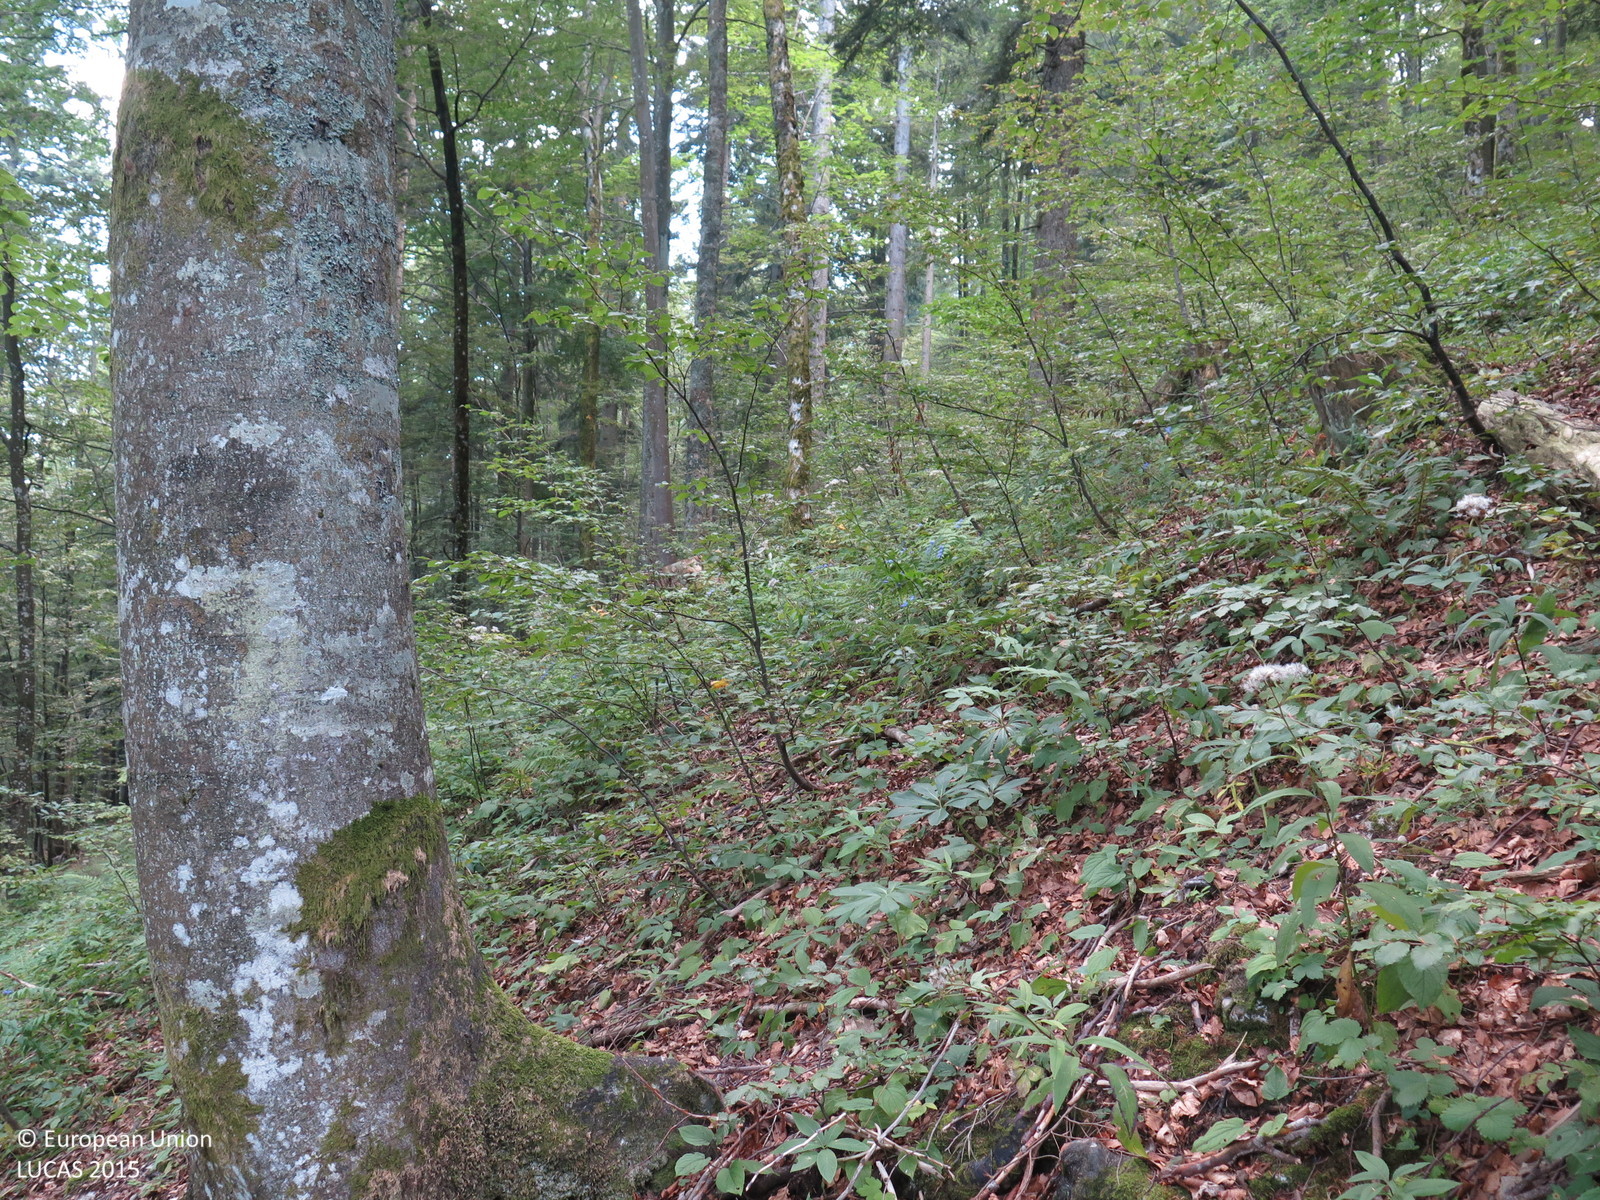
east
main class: Woodland
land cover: Other mixed woodland
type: mountainous beech forest
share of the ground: > 75 %
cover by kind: coniferous forest trees 75 %, broadleaved forest trees 25 %
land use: Forestry
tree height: > 5 m
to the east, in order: Other mixed woodland
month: August
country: HR
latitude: 45.3685
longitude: 14.9876
